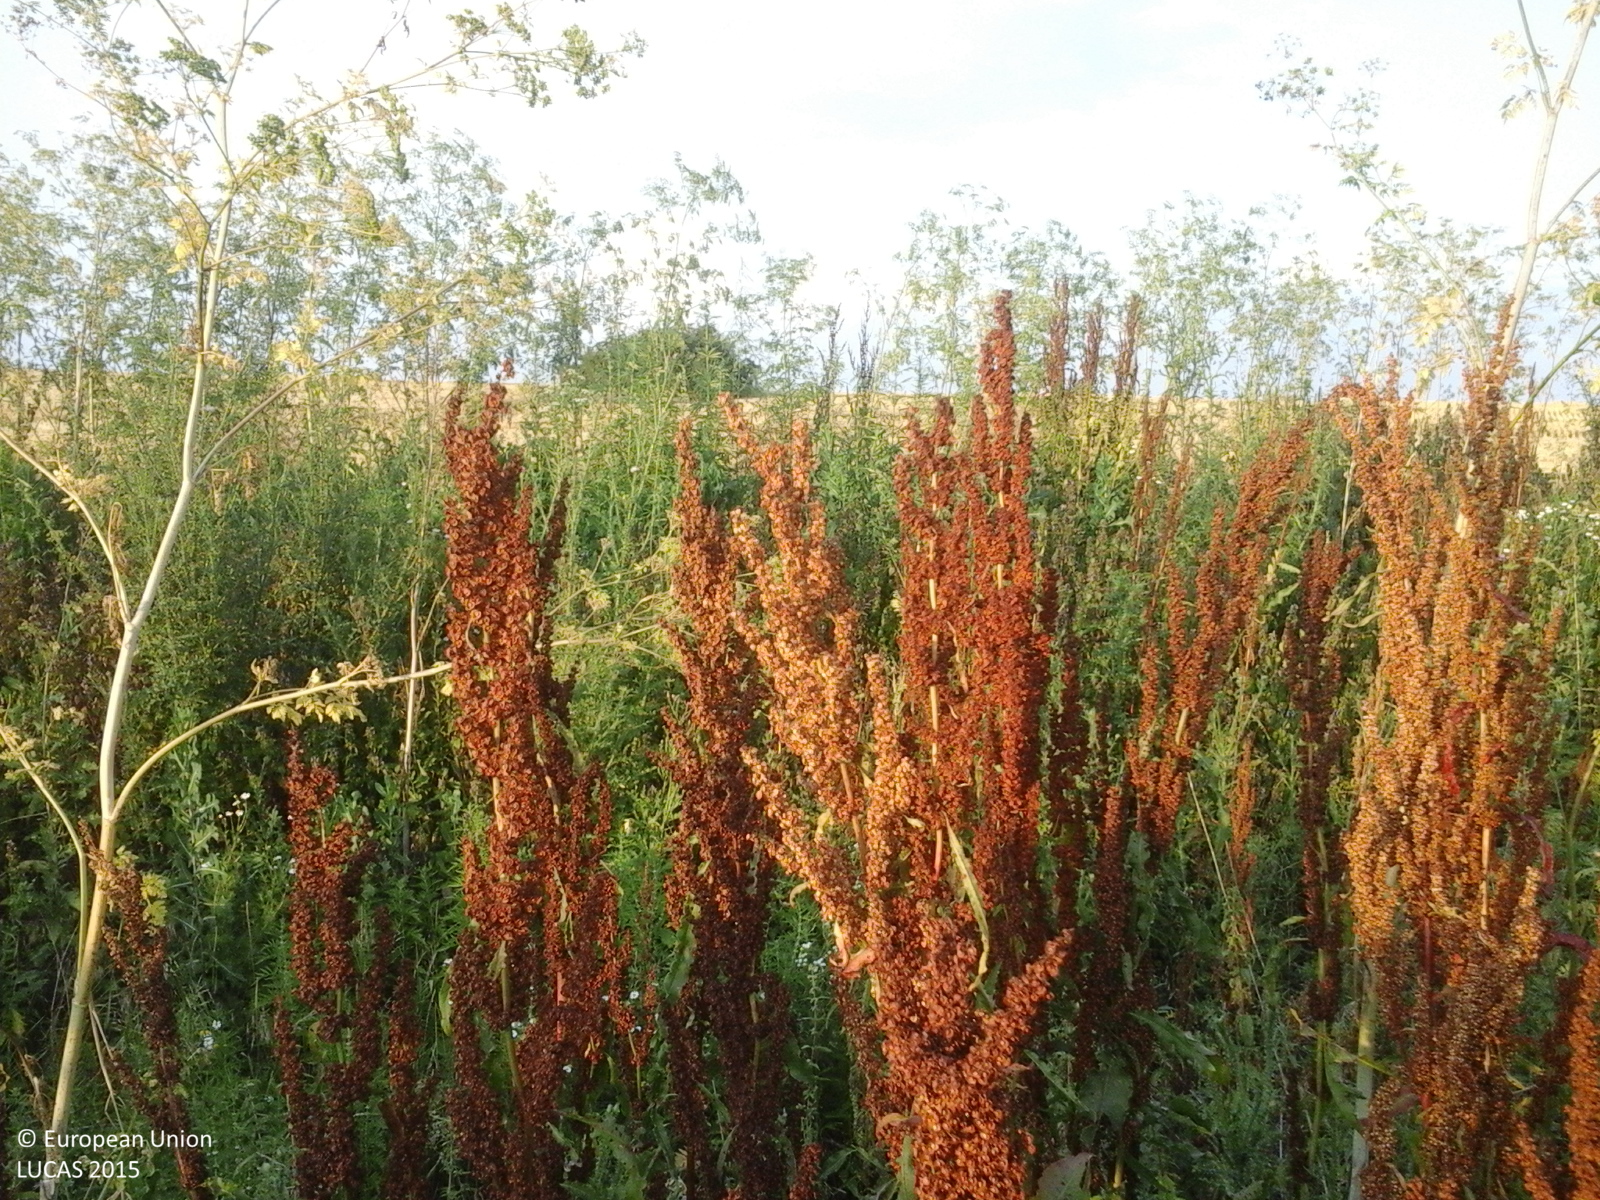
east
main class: Cropland
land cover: Sunflower
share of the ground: > 75 %
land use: Agriculture (excluding fallow land and kitchen gardens)
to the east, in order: Sunflower; Spontaneously vegetated surfaces; Ditches and canals; Spontaneously vegetated surfaces; Common wheat; Single bushes/trees; Common wheat; Grass margins; Tracks; Grass margins; Common wheat
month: July
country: RO
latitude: 44.1123
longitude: 25.9793
